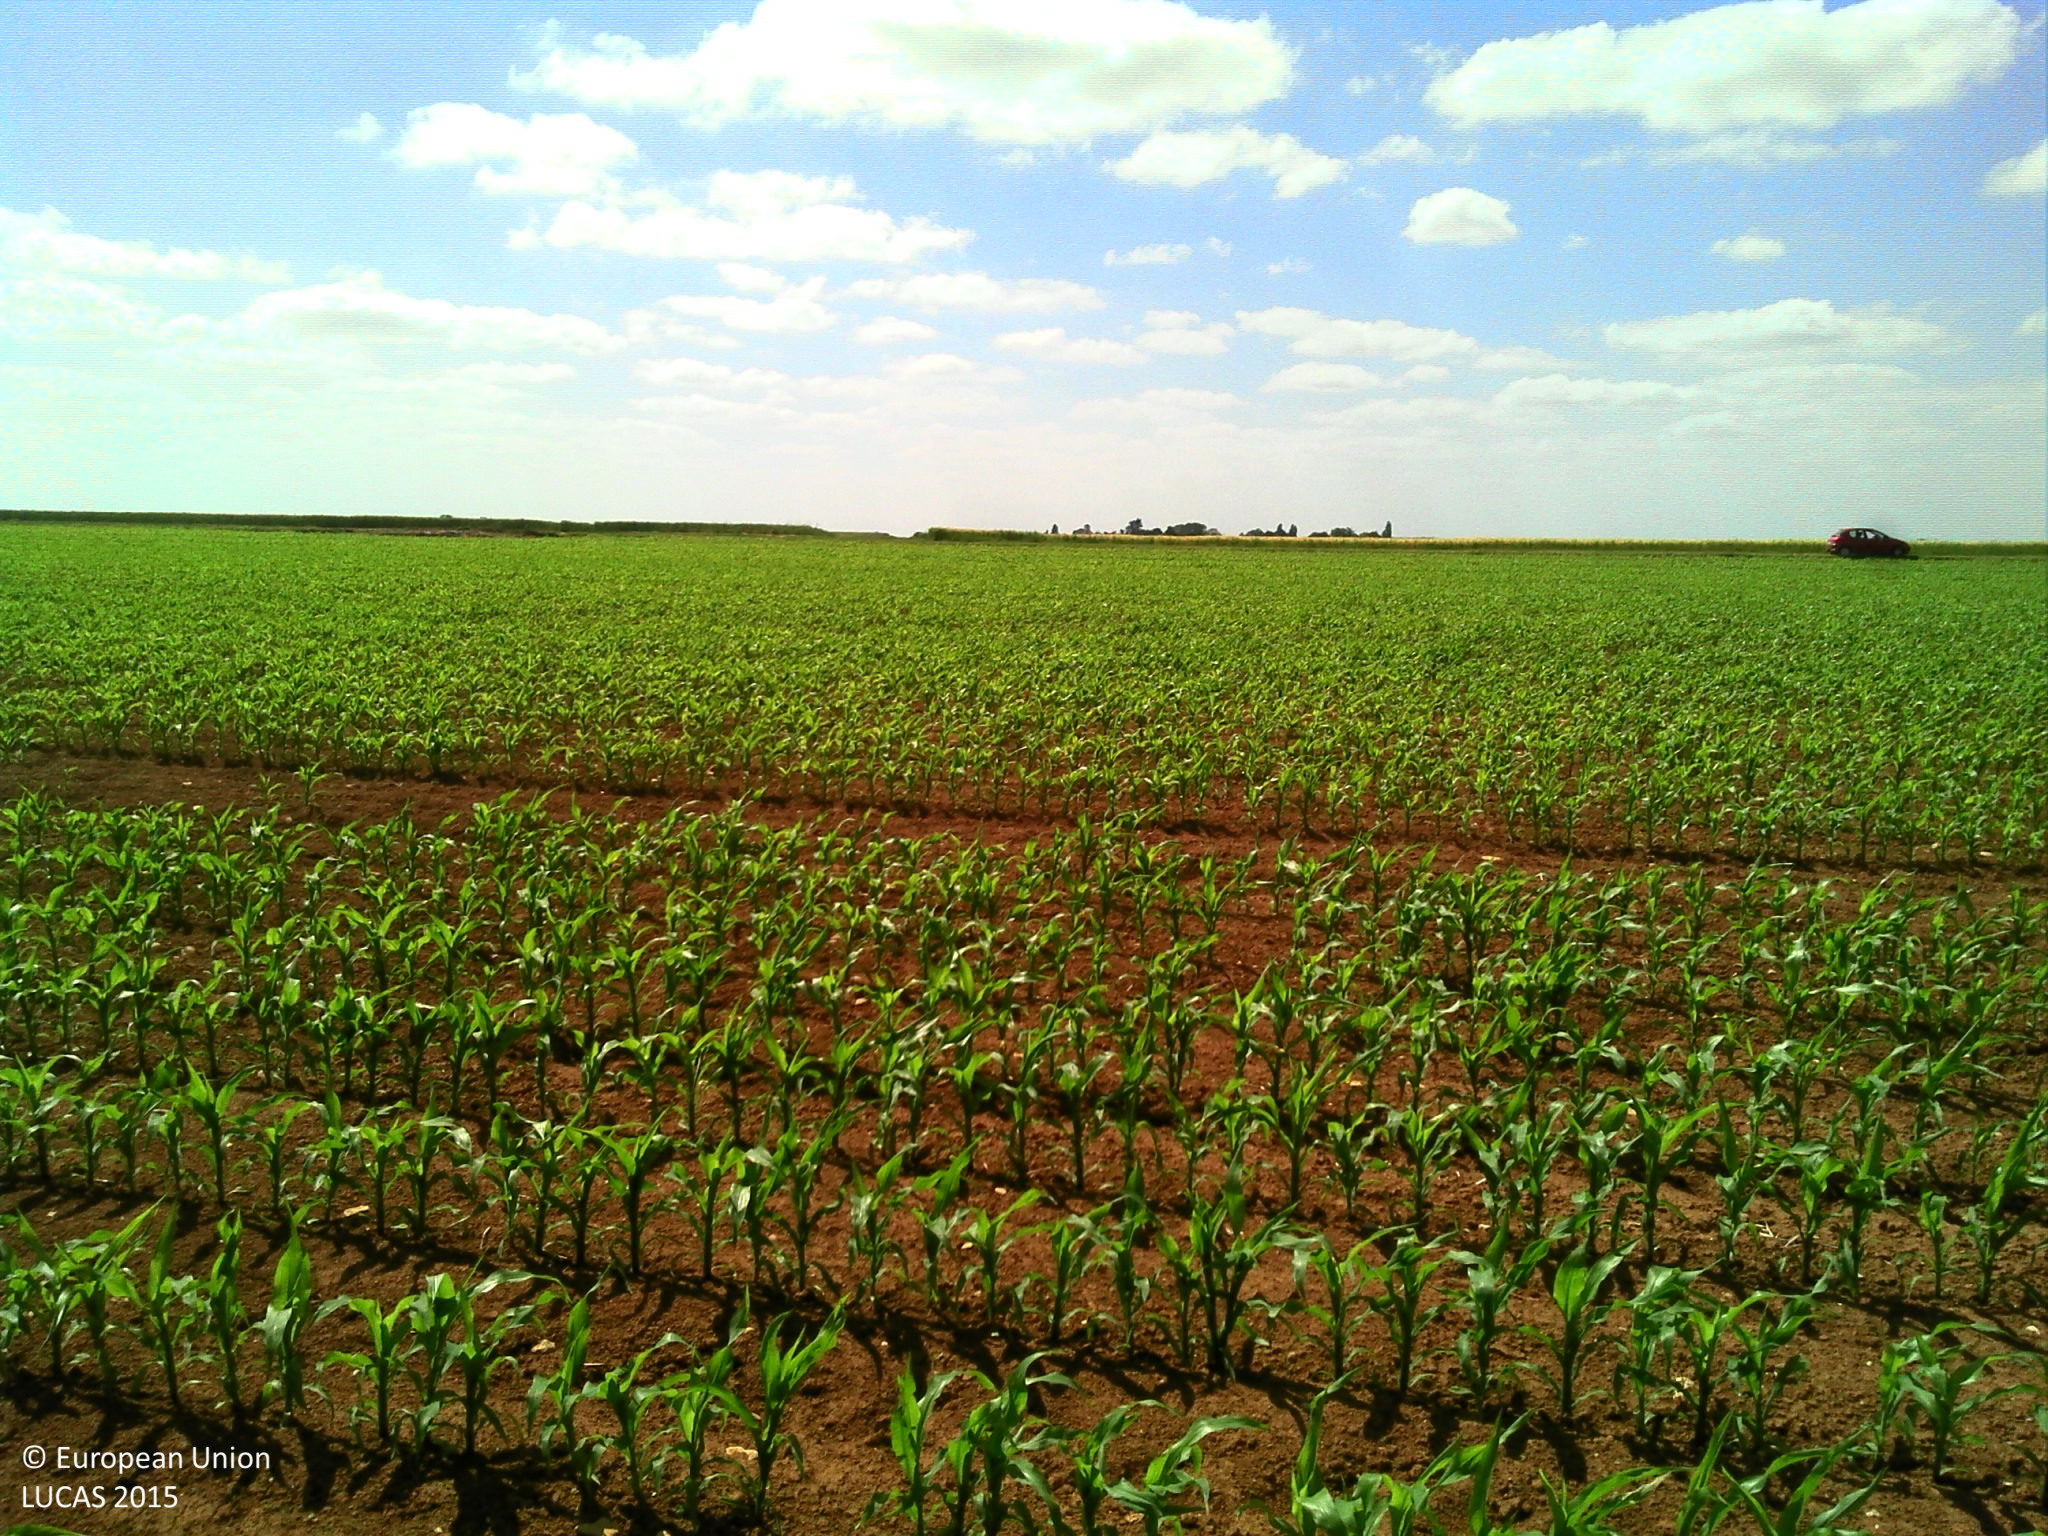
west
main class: Cropland
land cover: Maize
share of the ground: 25 - 50 %
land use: Agriculture (excluding fallow land and kitchen gardens)
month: June
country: FR
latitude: 48.0570
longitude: 1.4911
